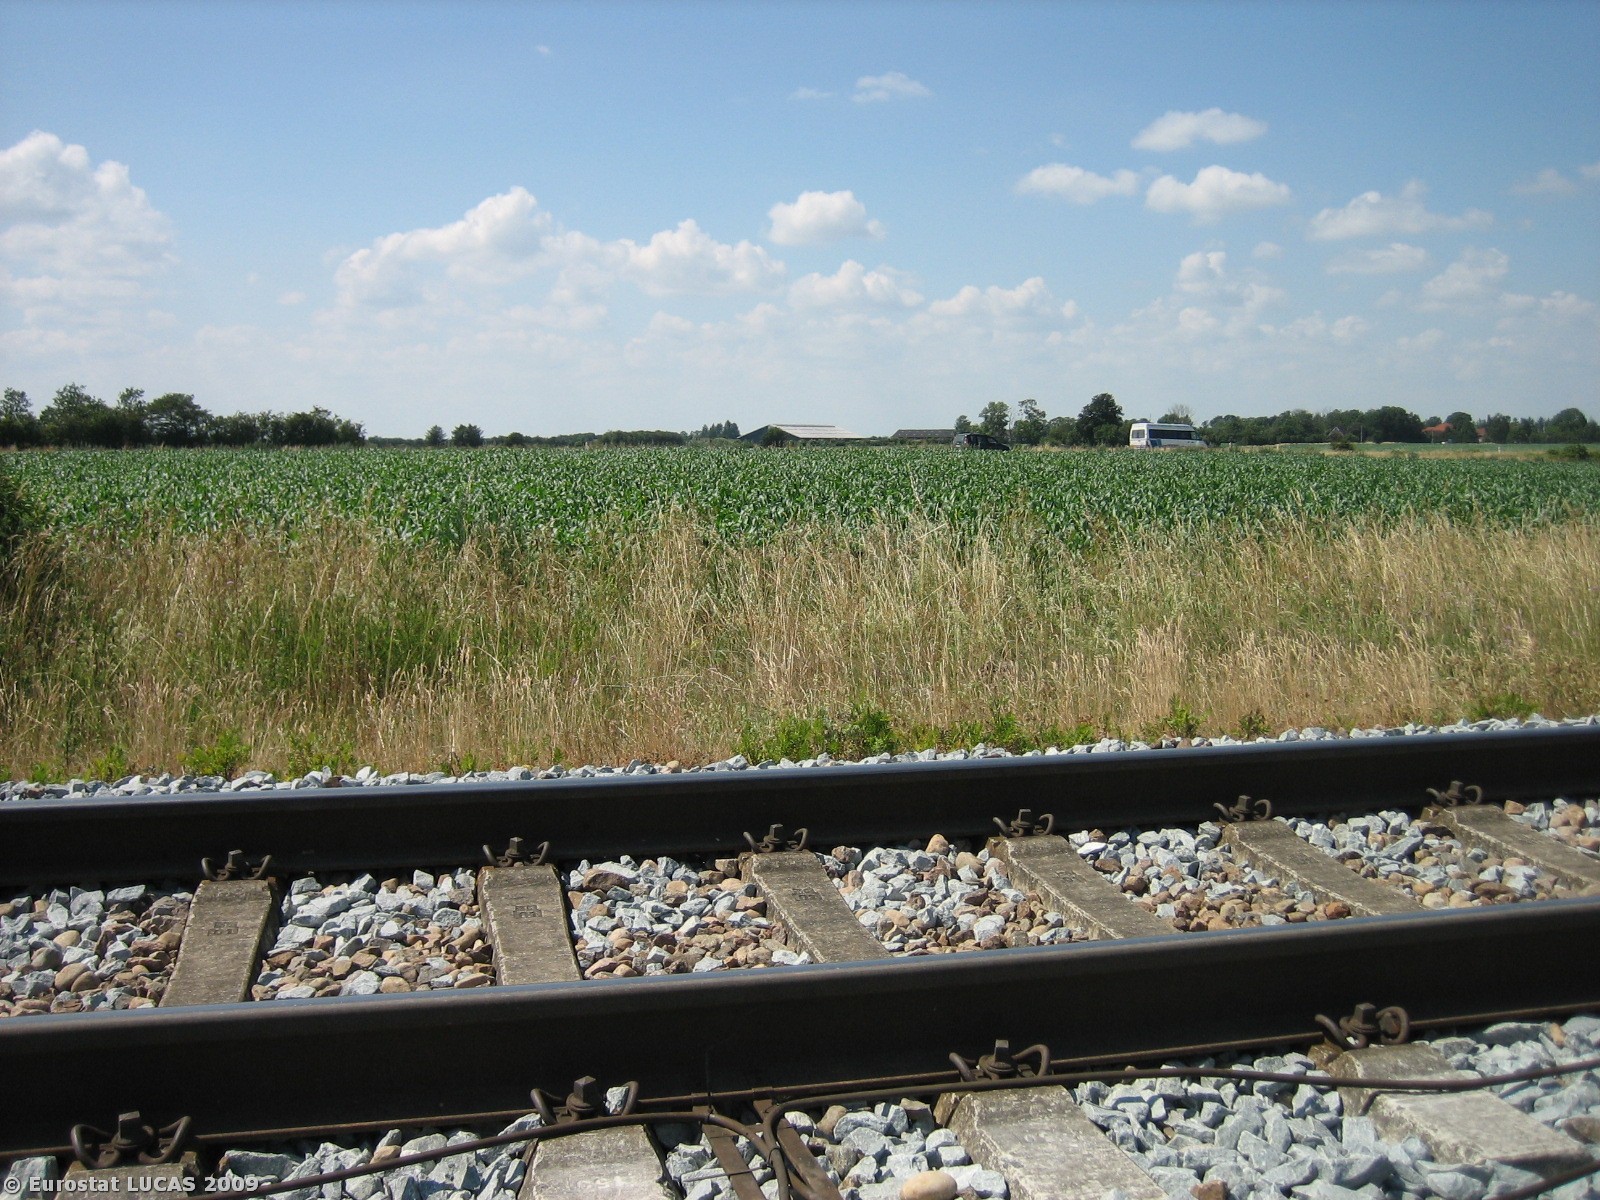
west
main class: Cropland
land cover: Common wheat
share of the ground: > 75 %
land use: Agriculture (excluding fallow land and kitchen gardens)
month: July
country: DK
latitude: 55.3050
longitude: 9.2918
